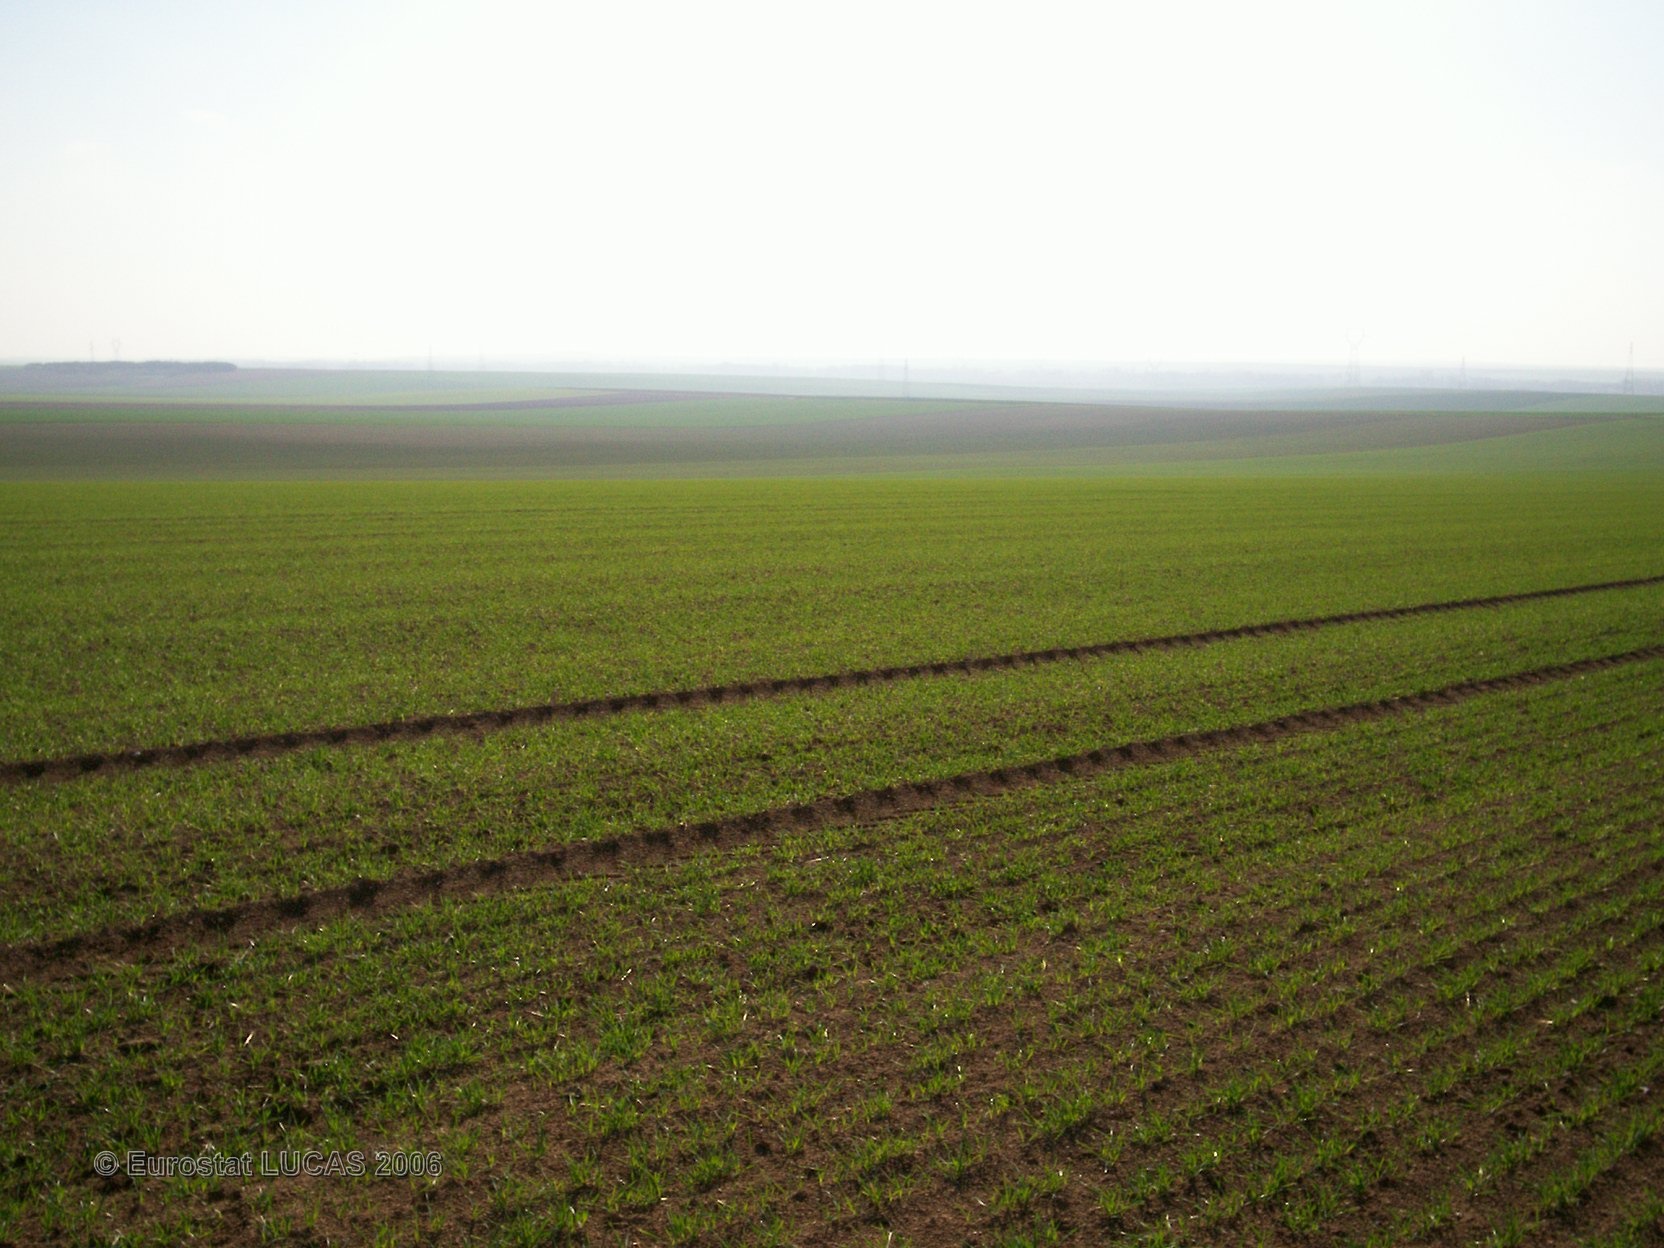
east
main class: Cropland
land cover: Barley
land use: Agriculture (excluding fallow land and kitchen gardens)
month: April
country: FR
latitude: 48.5337
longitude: 4.4310
